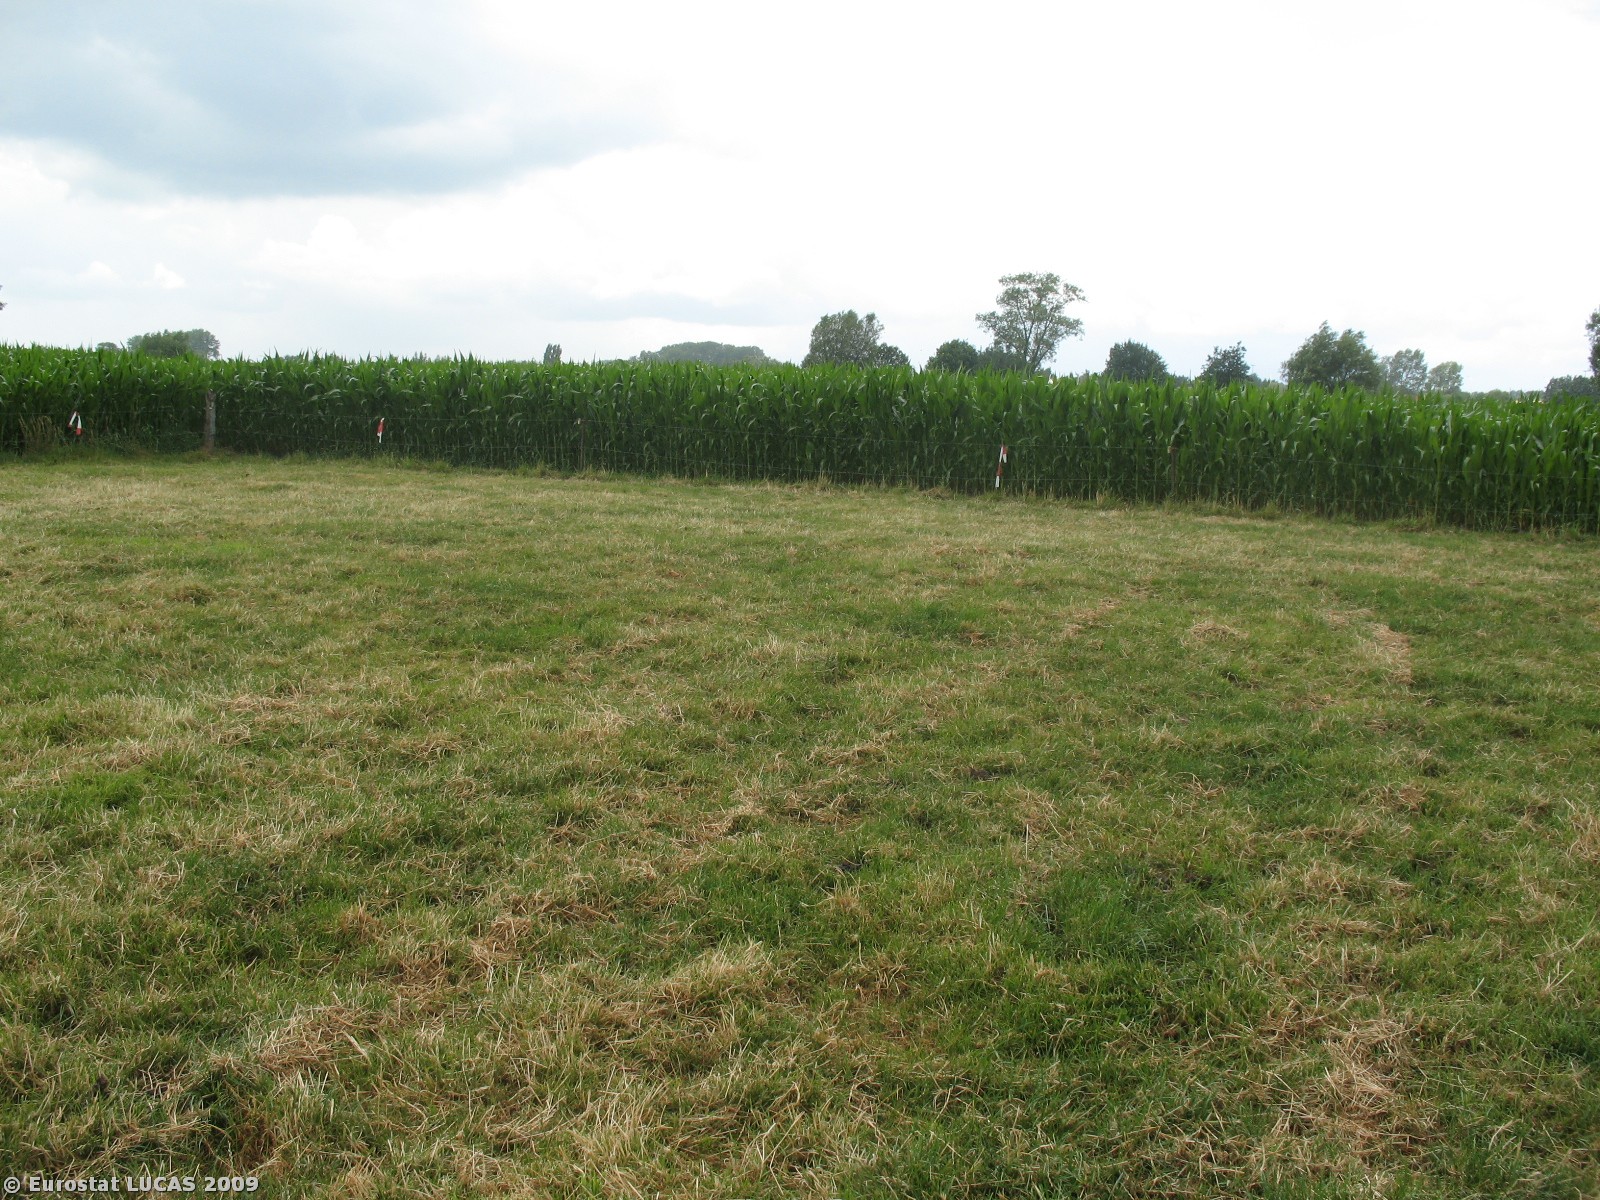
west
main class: Grassland
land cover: Grassland without tree/shrub cover
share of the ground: > 75 %
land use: Agriculture (excluding fallow land and kitchen gardens)
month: June
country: BE
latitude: 50.9845
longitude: 3.7110
